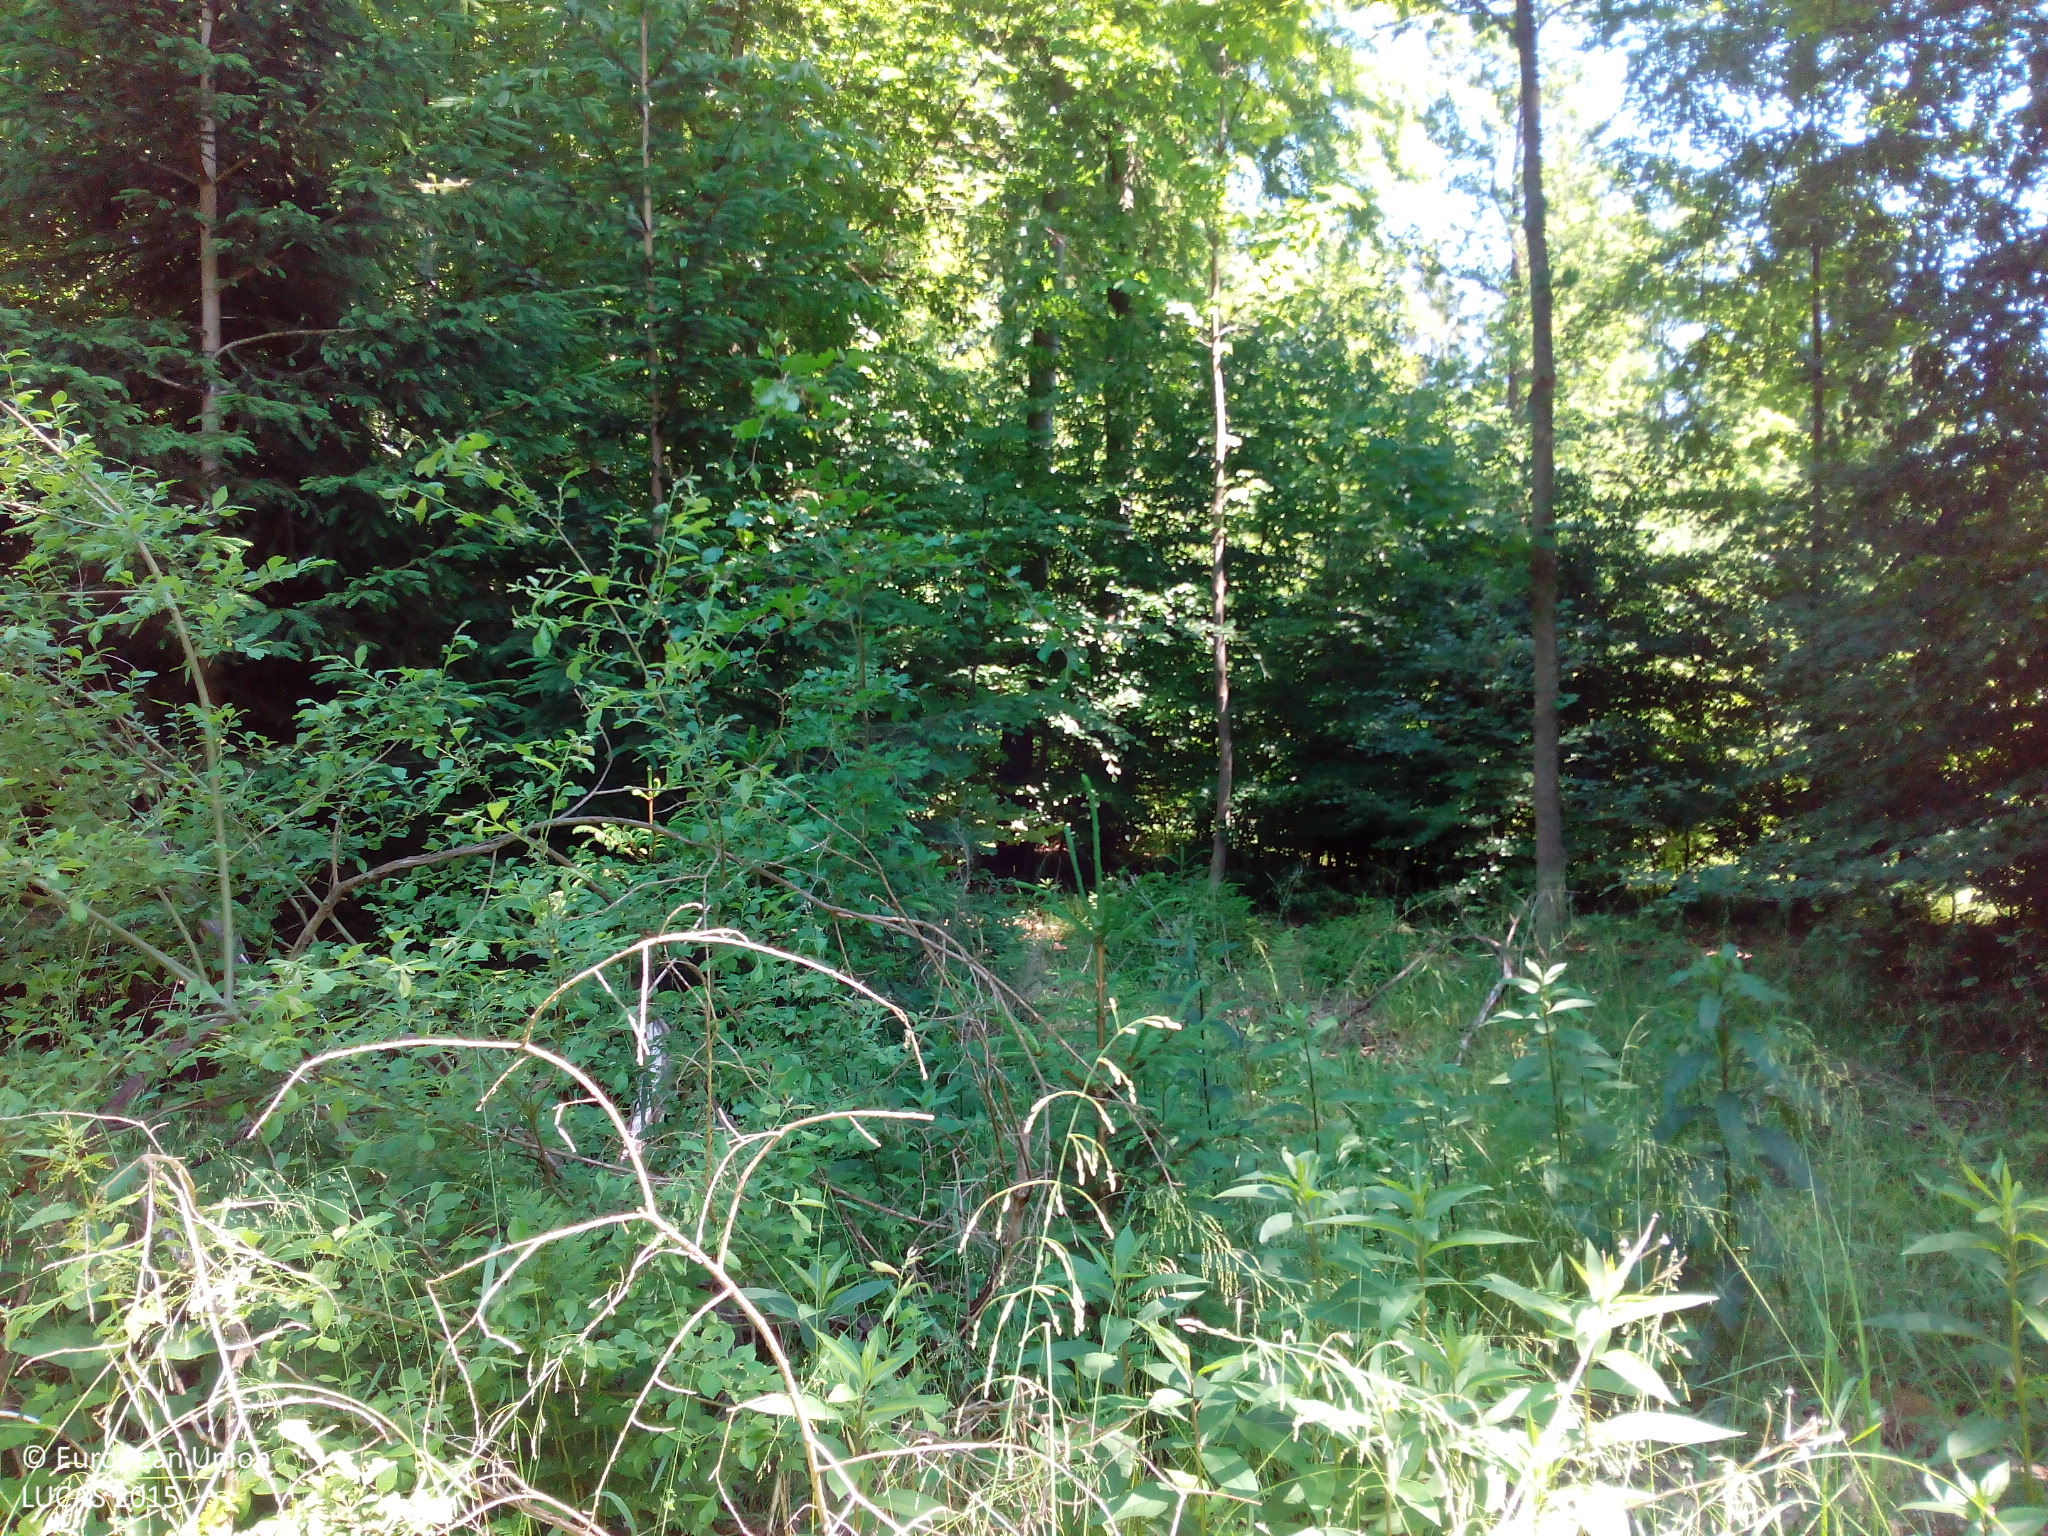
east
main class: Woodland
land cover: Spruce dominated mixed woodland
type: hemiboreal forest and nemoral coniferous forest and mixed broadleaved-coniferous forest
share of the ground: > 75 %
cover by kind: coniferous forest trees 50 %, broadleaved forest trees 40 %, shrubs 5 %, herbaceous plants 5 %
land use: Forestry
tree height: > 5 m
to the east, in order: Spruce dominated mixed woodland; Tracks; Broadleaved woodland; Tracks; Broadleaved woodland; Tracks; Spruce dominated mixed woodland; Broadleaved woodland
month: June
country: DE
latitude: 49.5532
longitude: 9.4058
